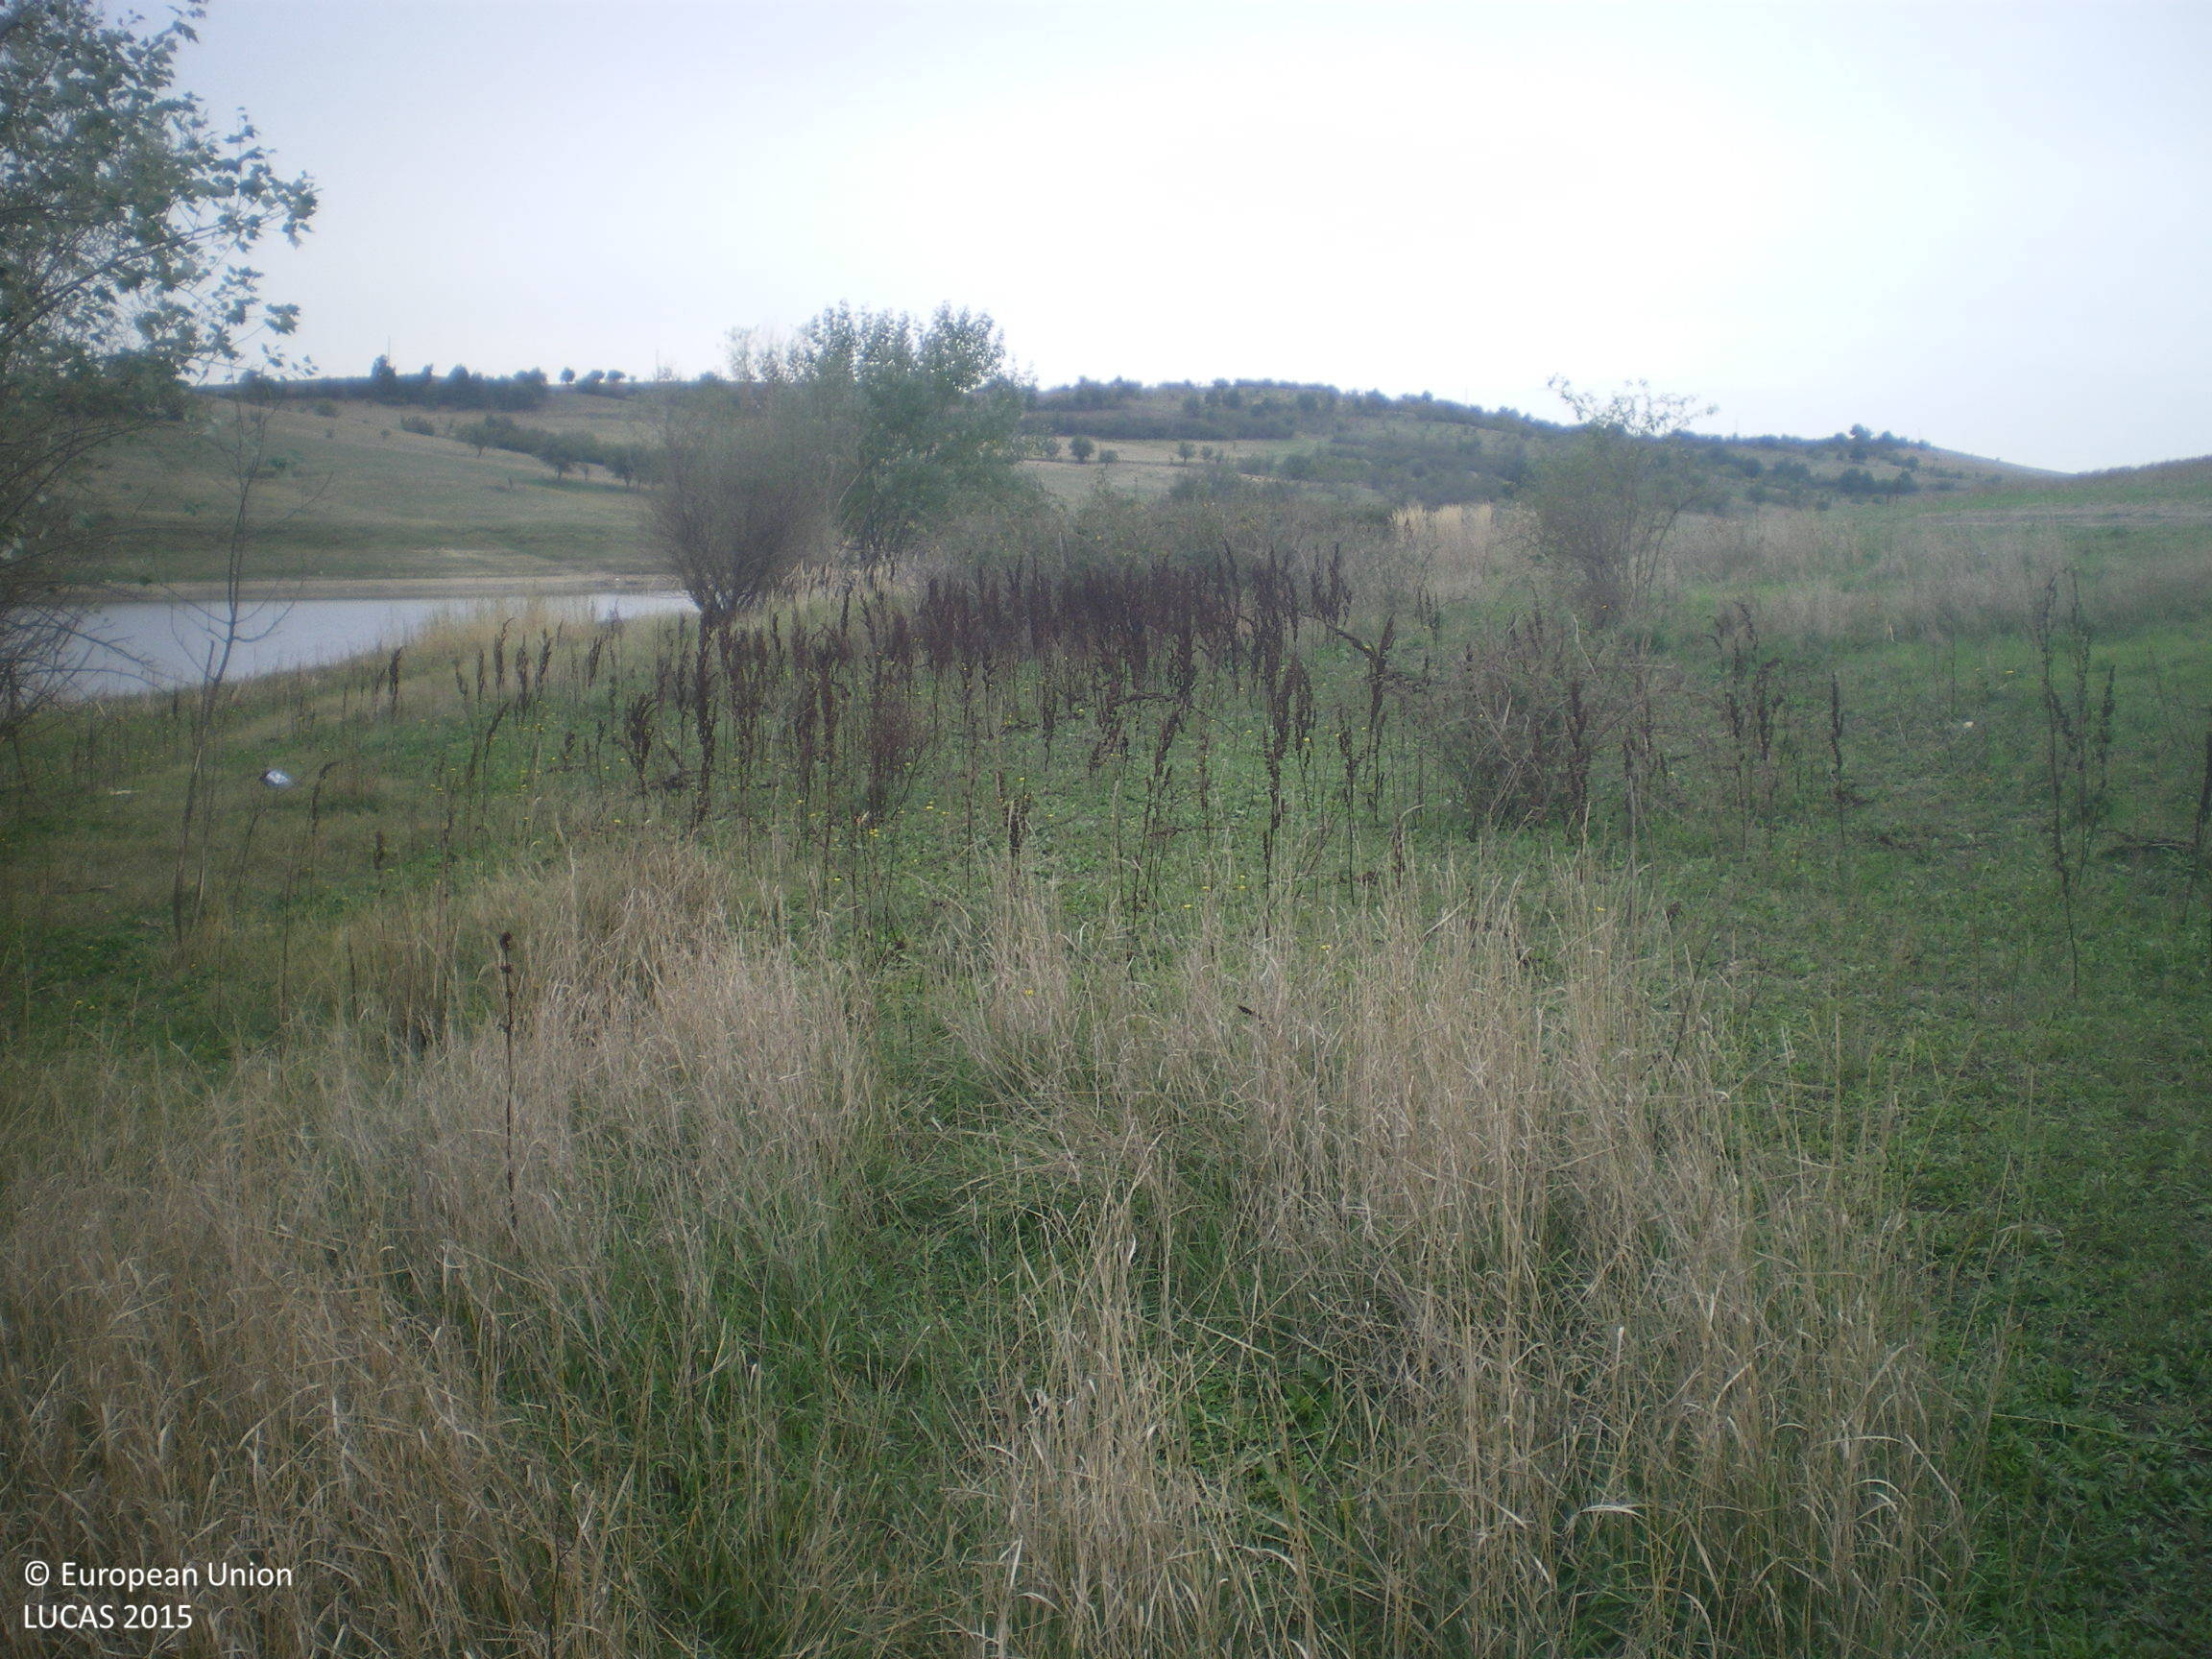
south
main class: Grassland
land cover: Grassland with sparse tree/shrub cover
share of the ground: > 75 %
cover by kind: herbaceous plants 90 %, broadleaved forest trees 5 %, shrubs 5 %
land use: Semi-natural and natural areas not in use
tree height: > 5 m
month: October
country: BG
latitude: 41.9371
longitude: 26.0309
